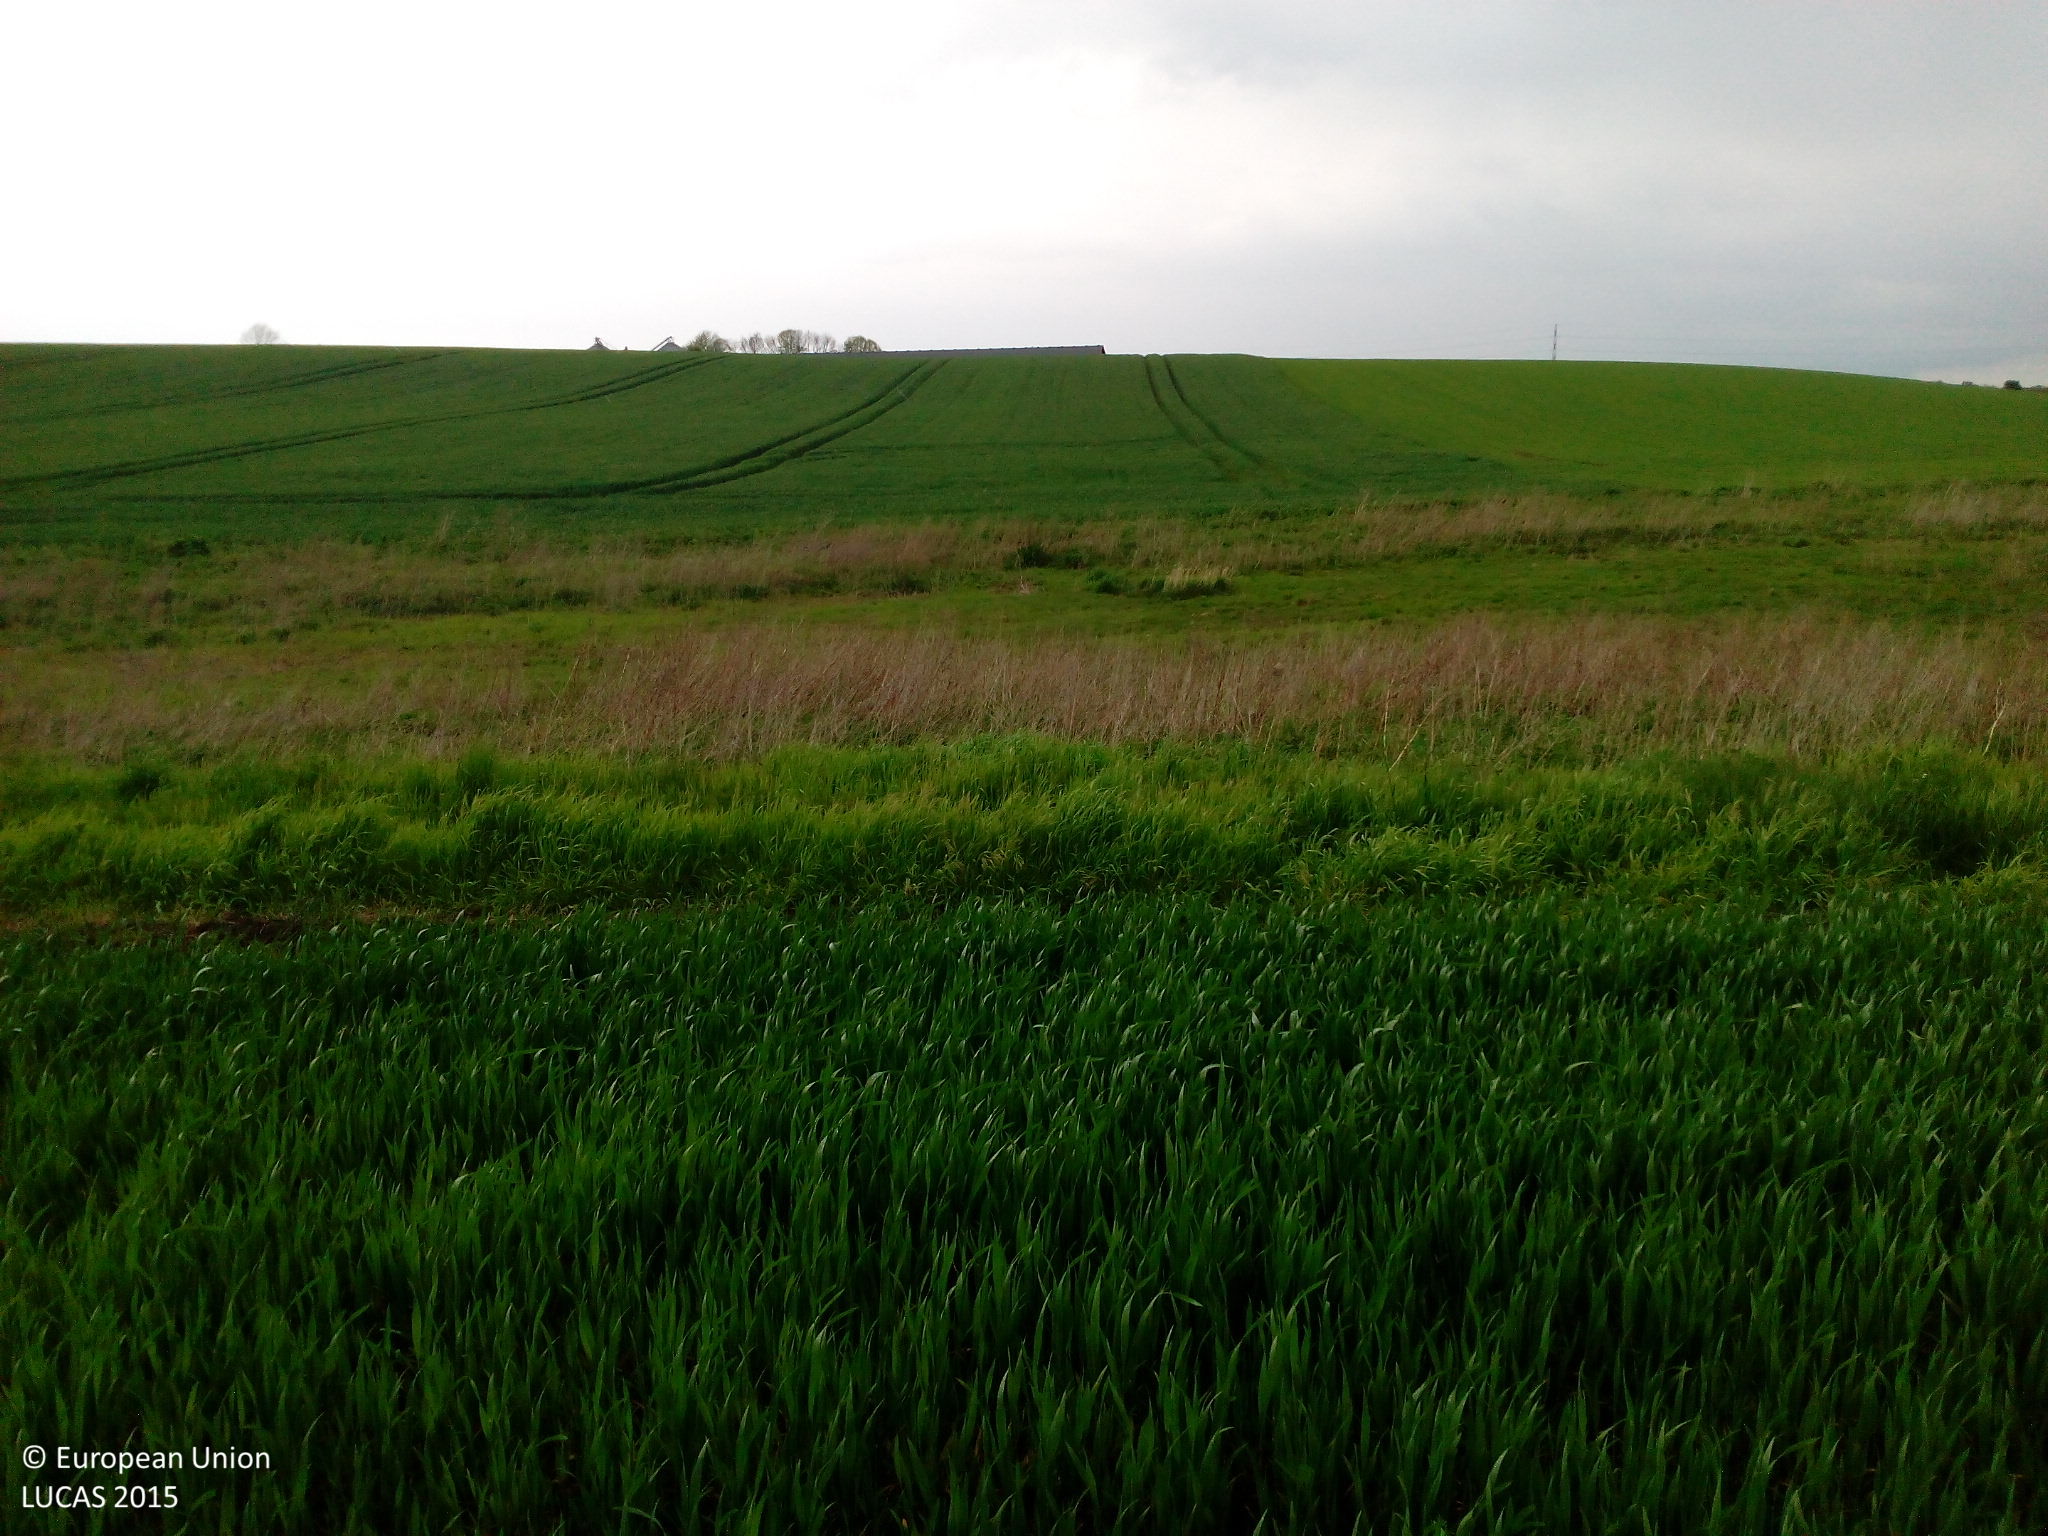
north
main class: Cropland
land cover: Common wheat
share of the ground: > 75 %
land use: Agriculture (excluding fallow land and kitchen gardens)
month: May
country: DK
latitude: 55.6150
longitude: 11.9829
